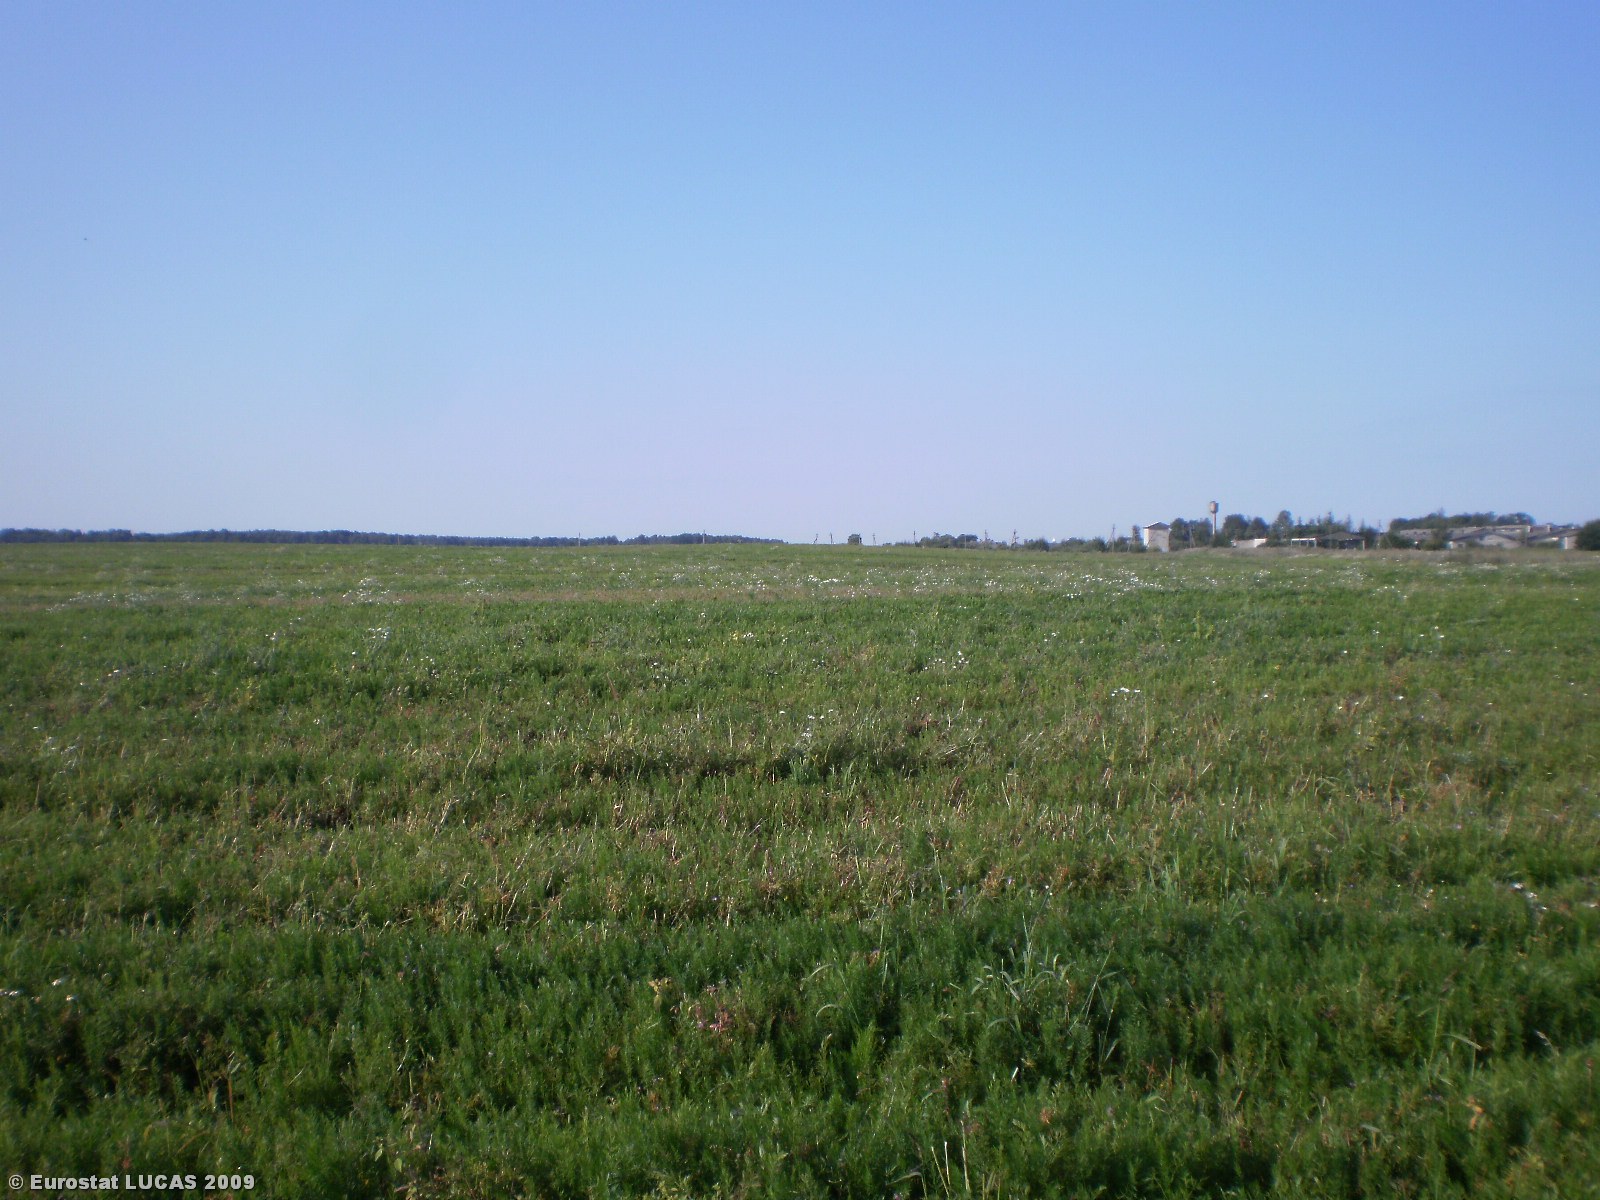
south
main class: Cropland
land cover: Other cereals
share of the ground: > 75 %
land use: Agriculture (excluding fallow land and kitchen gardens)
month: August
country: LT
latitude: 55.5381
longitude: 24.9908
